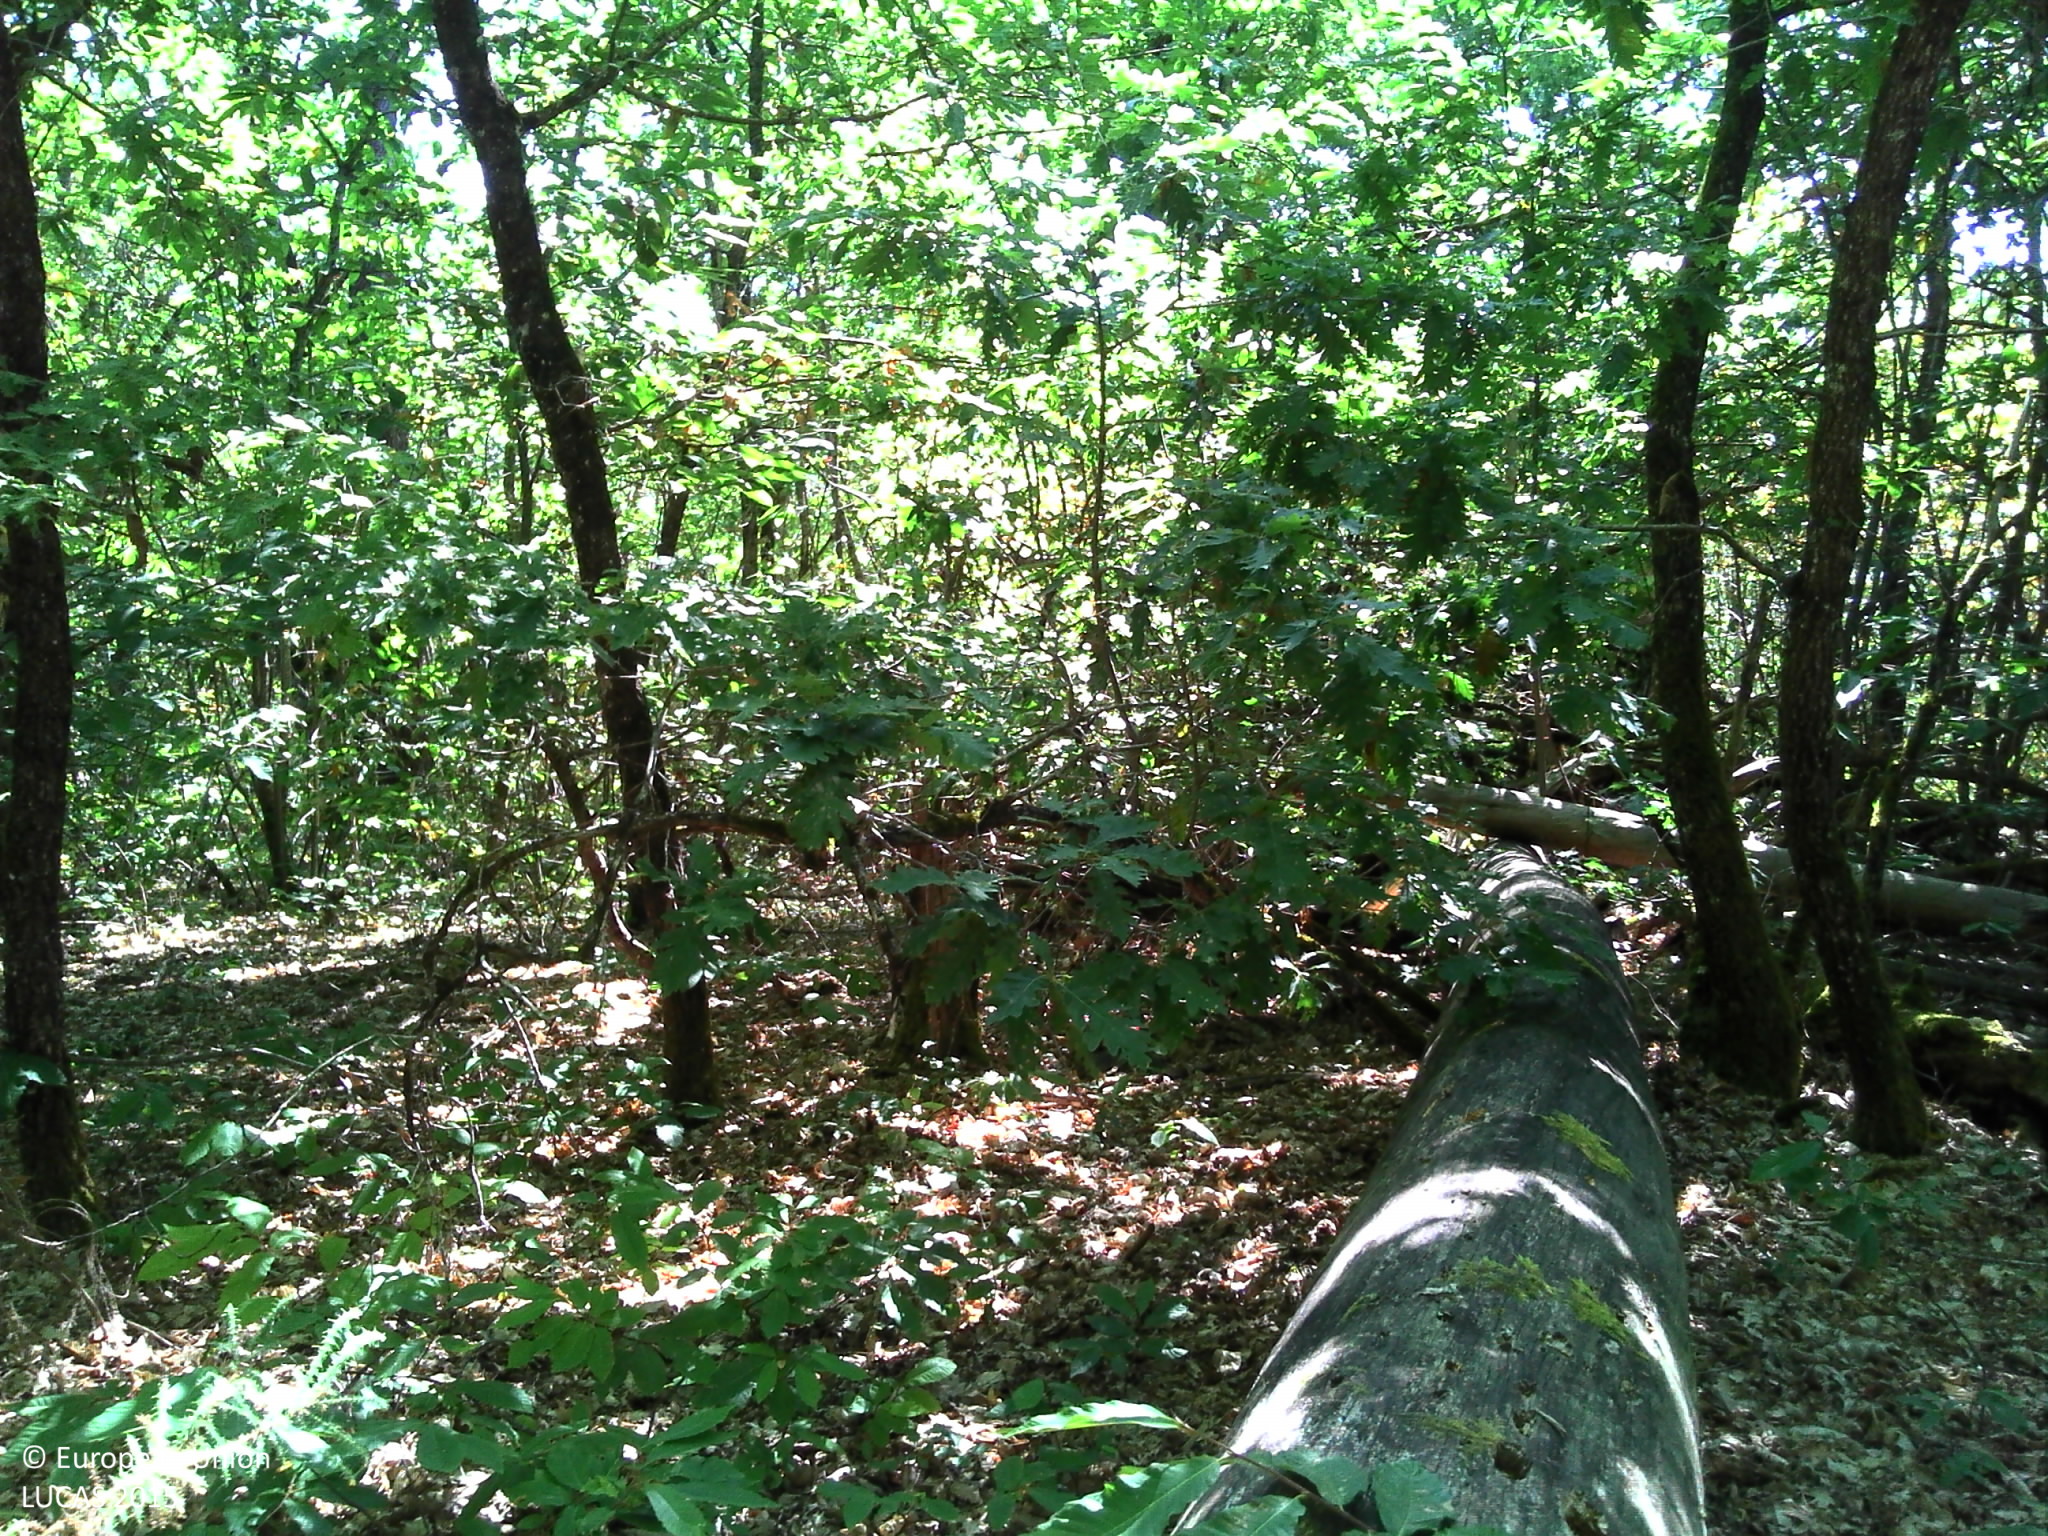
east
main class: Woodland
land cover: Broadleaved woodland
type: acidophilous oak and oak-birch forest
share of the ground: > 75 %
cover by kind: broadleaved forest trees 80 %, herbaceous plants 10 %, shrubs 5 %, lichens and mosses 5 %
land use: Forestry
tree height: > 5 m
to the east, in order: Broadleaved woodland; Tracks; Grassland without tree/shrub cover; Broadleaved woodland; Ditches and canals; Paved roads, cycling and walking lanes; Broadleaved woodland
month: July
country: FR
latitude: 44.9167
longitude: 0.5530
